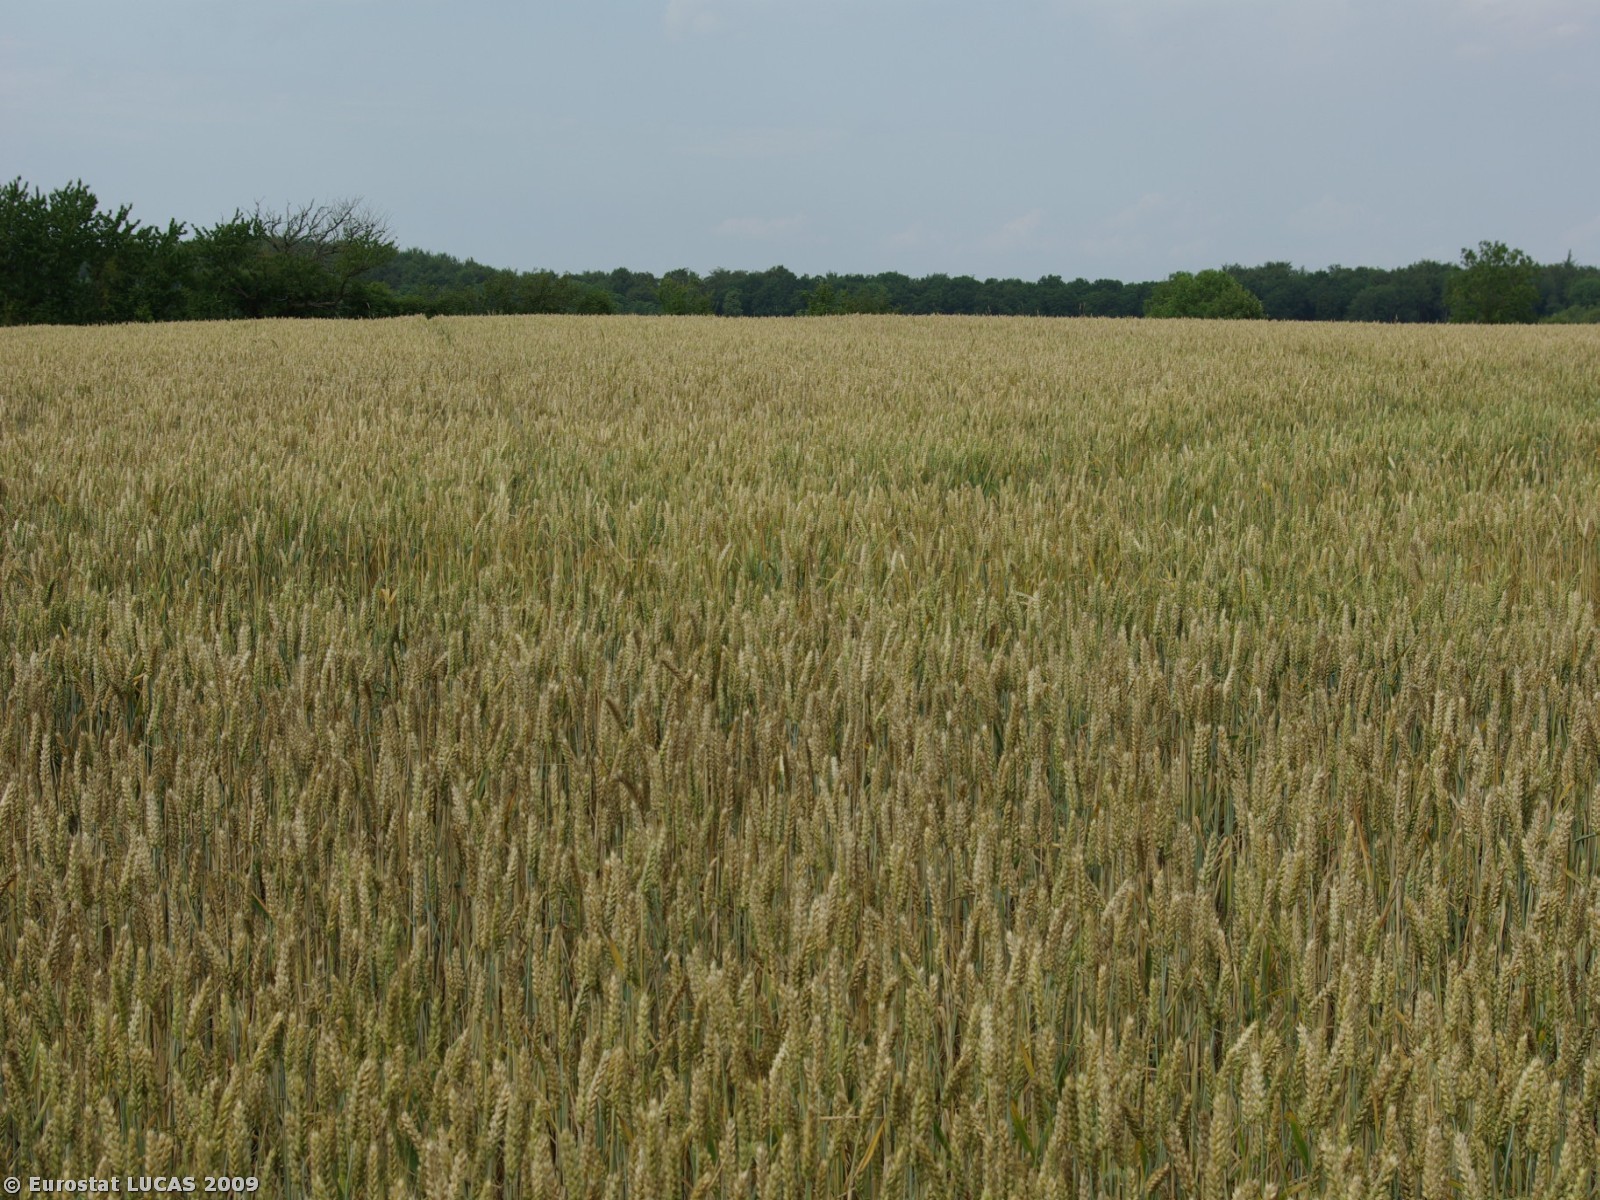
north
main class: Cropland
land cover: Common wheat
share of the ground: > 75 %
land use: Agriculture (excluding fallow land and kitchen gardens)
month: July
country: DK
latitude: 55.0014
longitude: 9.9219
